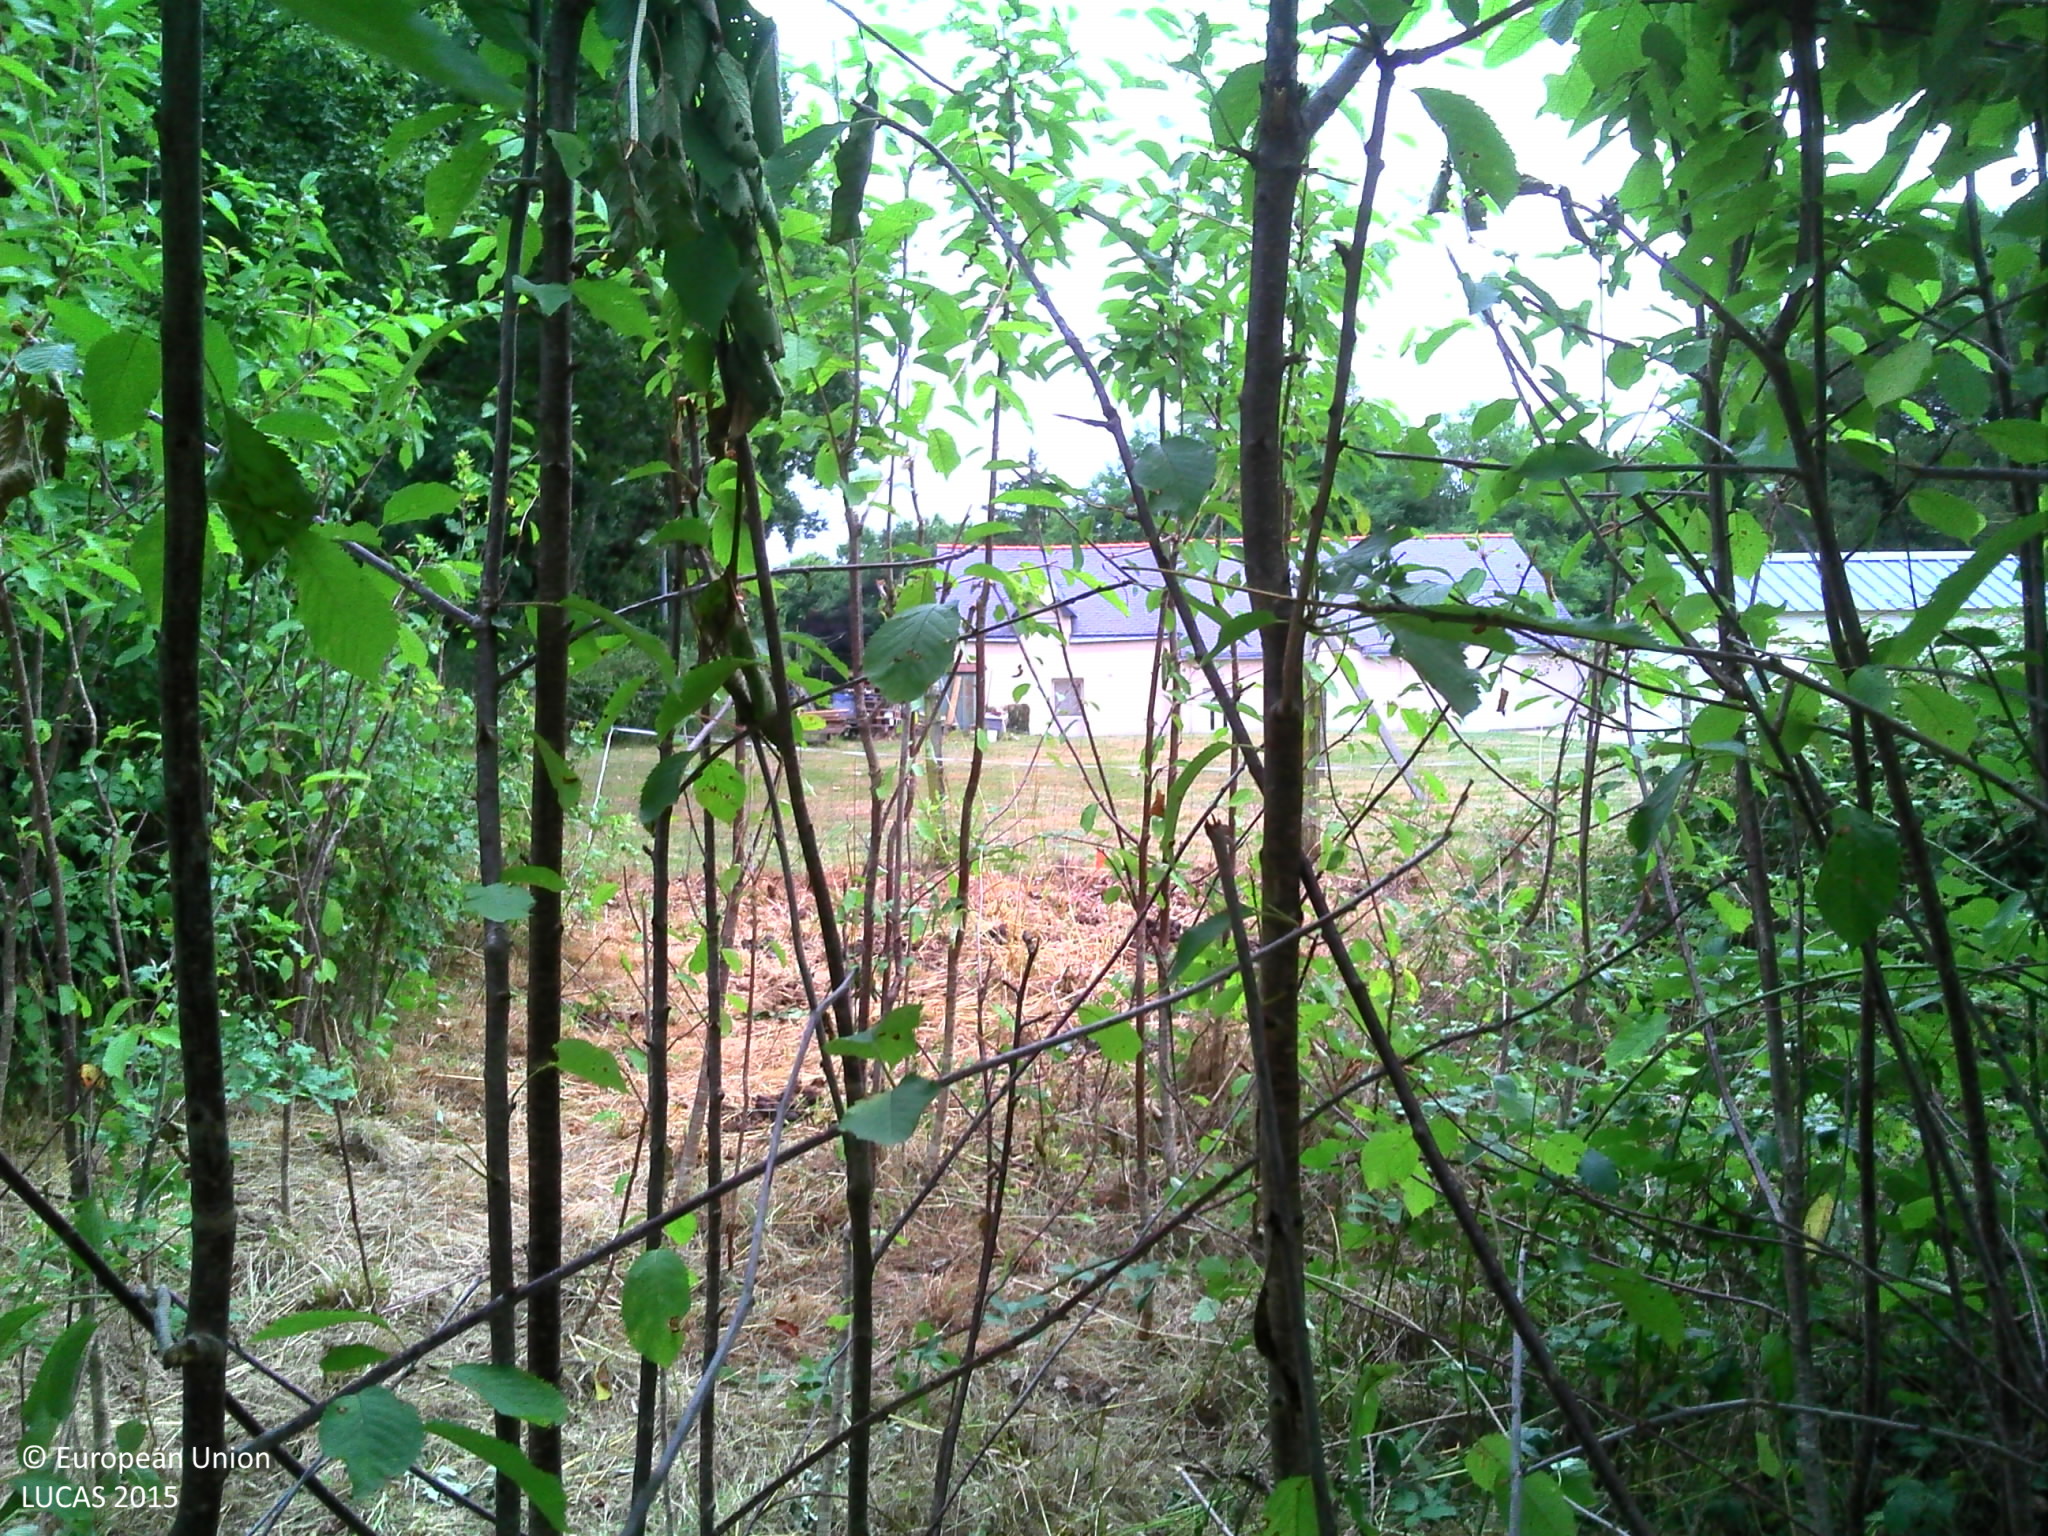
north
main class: Shrubland
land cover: Shrubland with sparse tree cover
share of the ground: > 75 %
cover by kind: shrubs 50 %, herbaceous plants 45 %, broadleaved forest trees 5 %
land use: Agriculture (excluding fallow land and kitchen gardens)
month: July
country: FR
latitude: 47.5329
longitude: -1.9645
